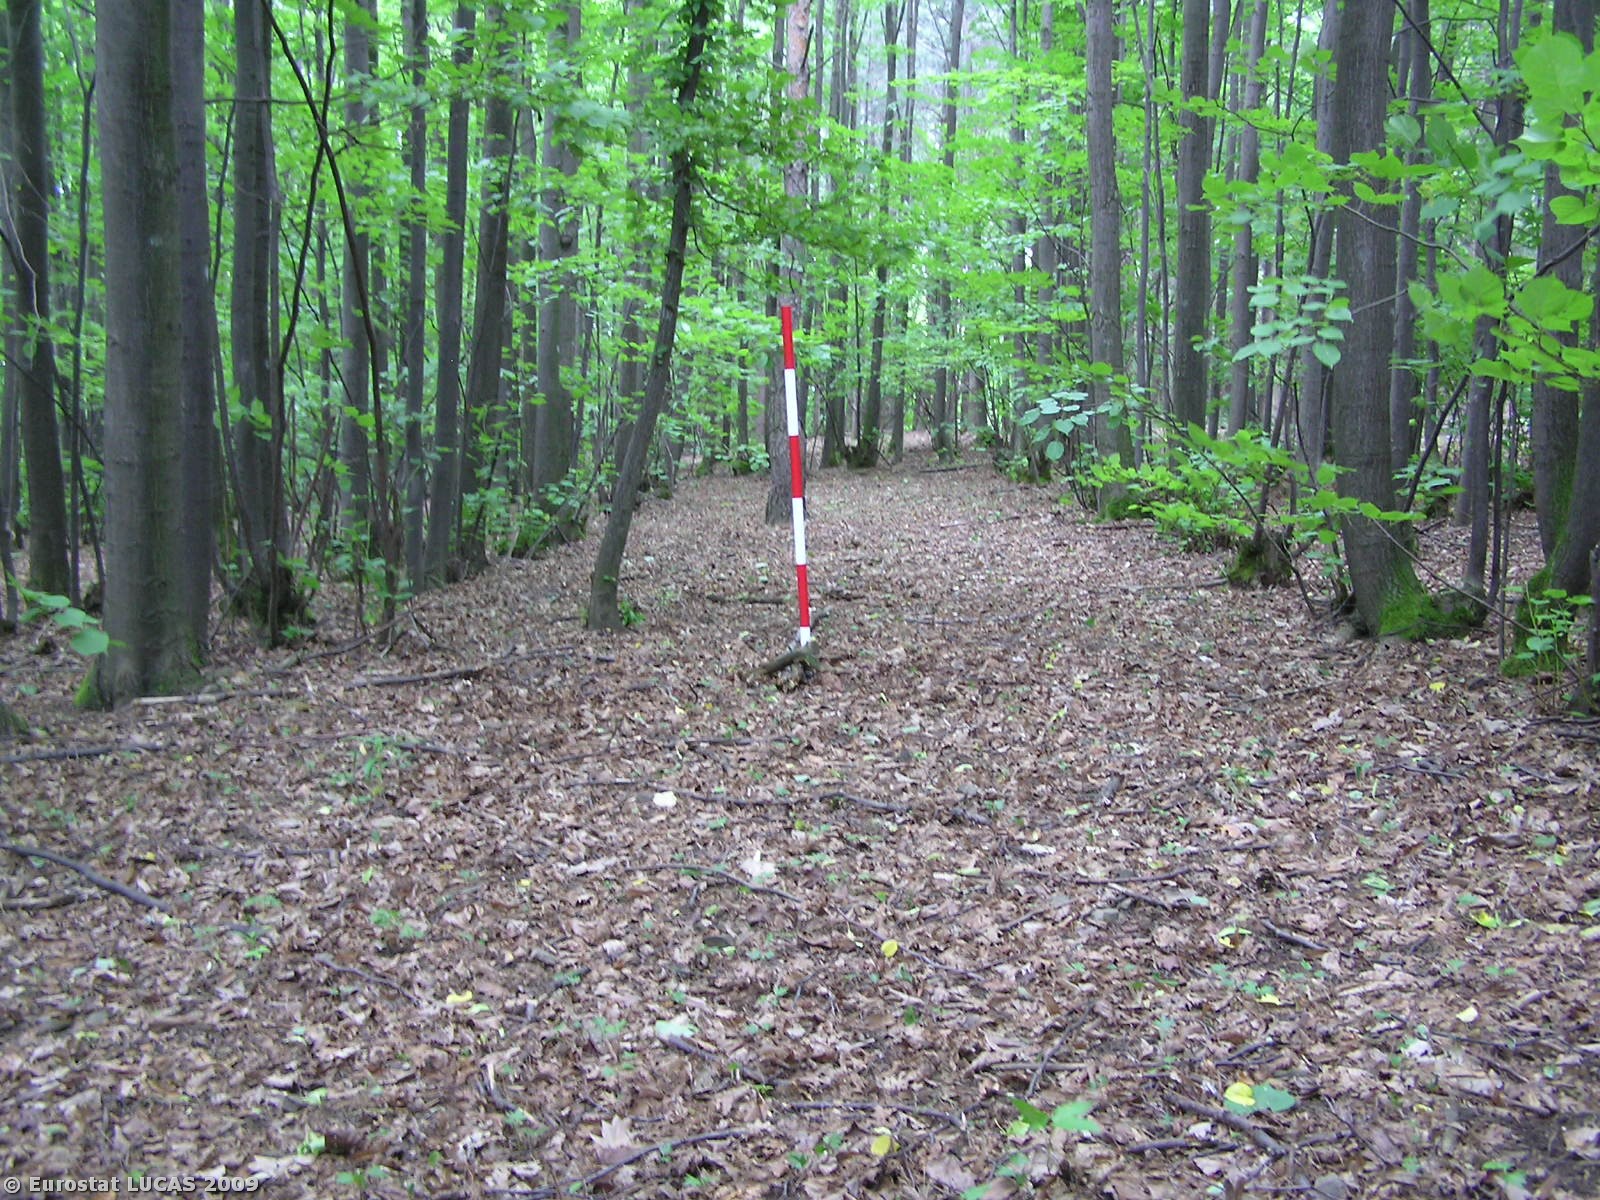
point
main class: Woodland
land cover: Broadleaved woodland
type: beech forest
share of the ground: > 75 %
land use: Forestry
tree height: > 5 m
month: June
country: CZ
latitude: 50.2160
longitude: 17.6511
